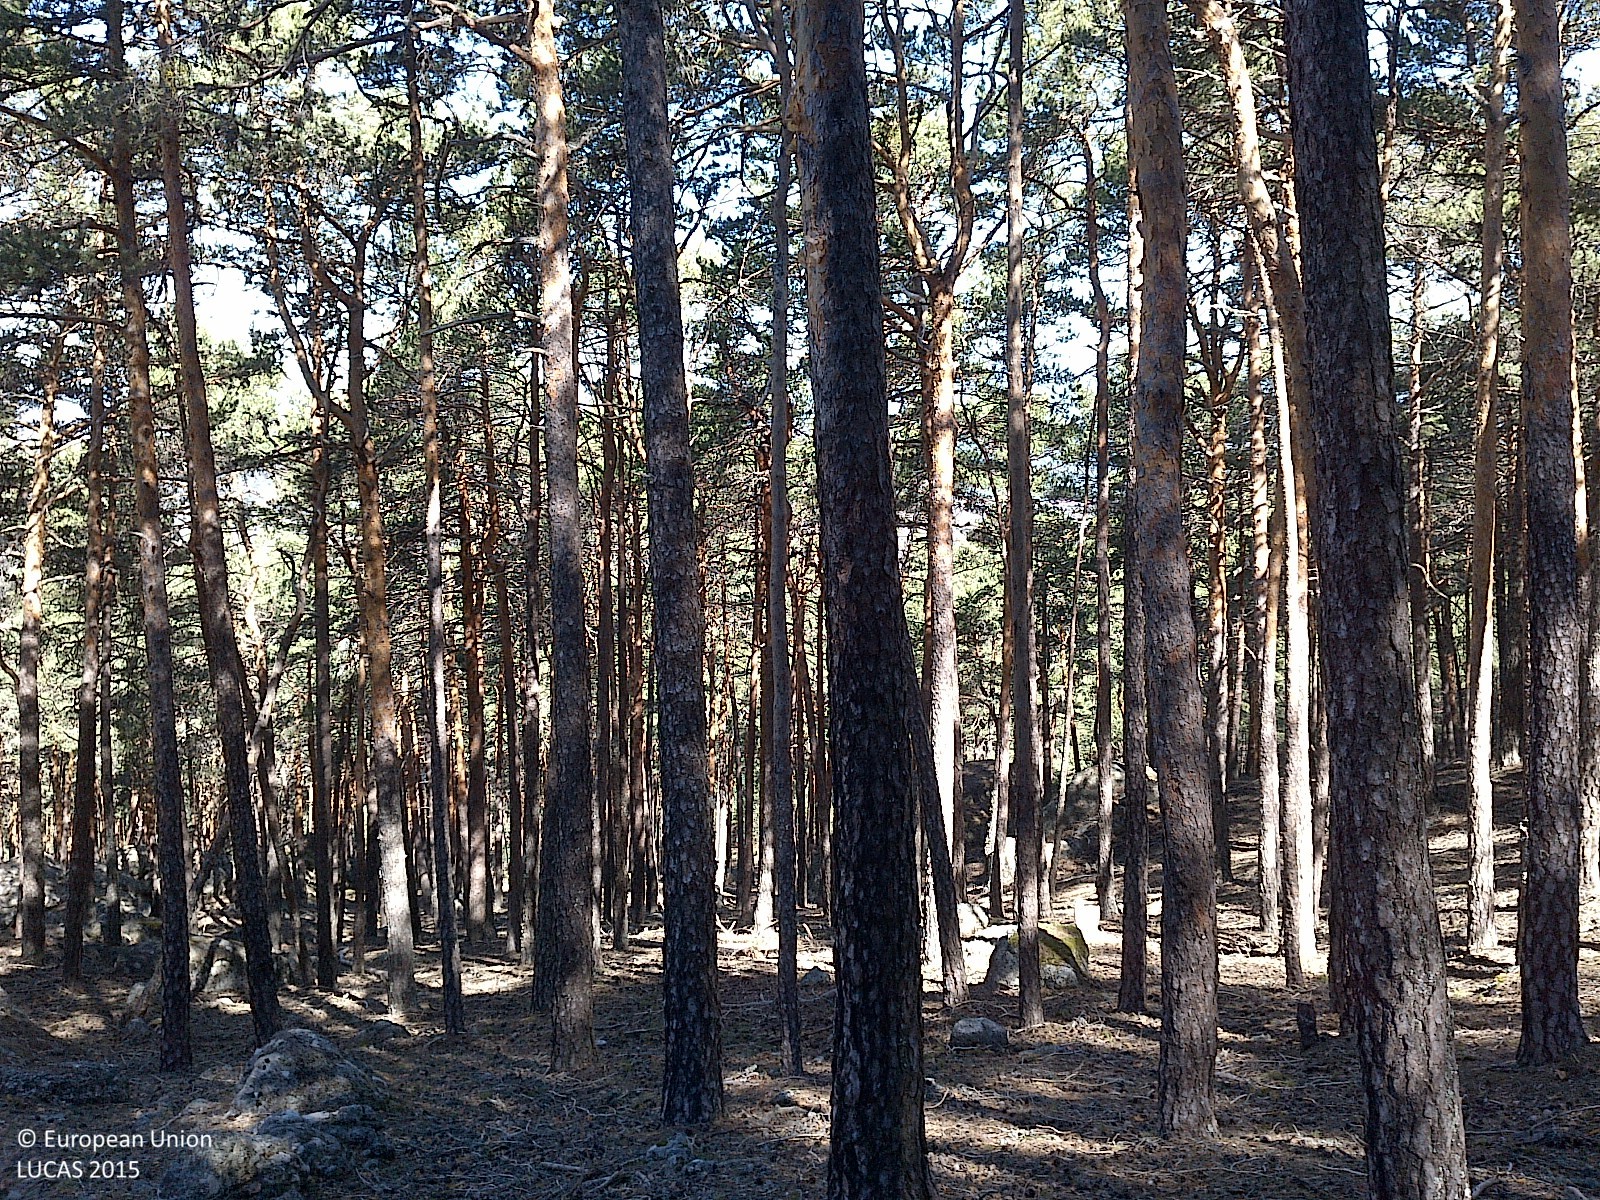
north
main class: Woodland
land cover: Pine dominated coniferous woodland
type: coniferous forest of the mediterranean region
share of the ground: > 75 %
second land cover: Grassland without tree/shrub cover
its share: 10 - 25 %
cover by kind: coniferous forest trees 75 %, herbaceous plants 15 %, unconsolidated bare surface 10 %
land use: Forestry
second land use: Agriculture (excluding fallow land and kitchen gardens)
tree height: > 5 m
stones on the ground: 10 - 25 %
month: April
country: ES
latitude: 41.9292
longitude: -3.0835
